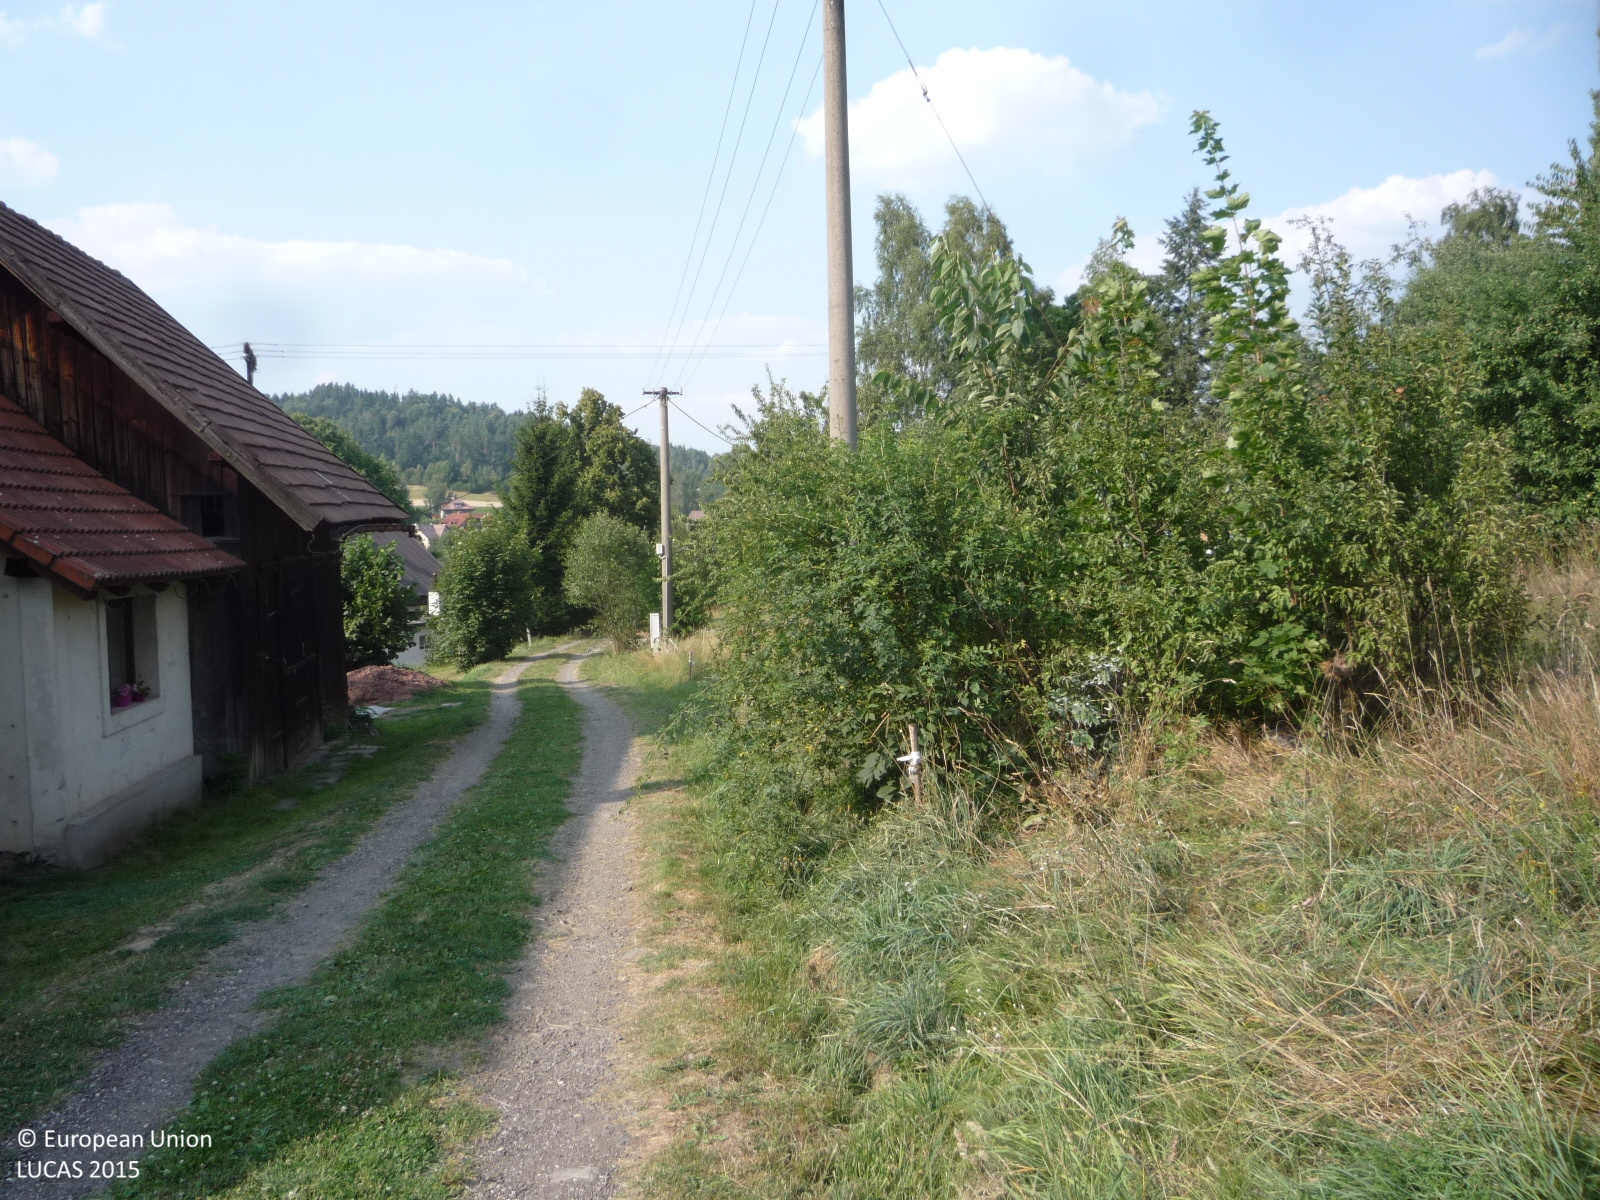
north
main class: Grassland
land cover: Grassland with sparse tree/shrub cover
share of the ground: > 75 %
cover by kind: herbaceous plants 90 %, broadleaved forest trees 5 %, shrubs 5 %
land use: Semi-natural and natural areas not in use
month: August
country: CZ
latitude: 50.6016
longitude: 15.3019
